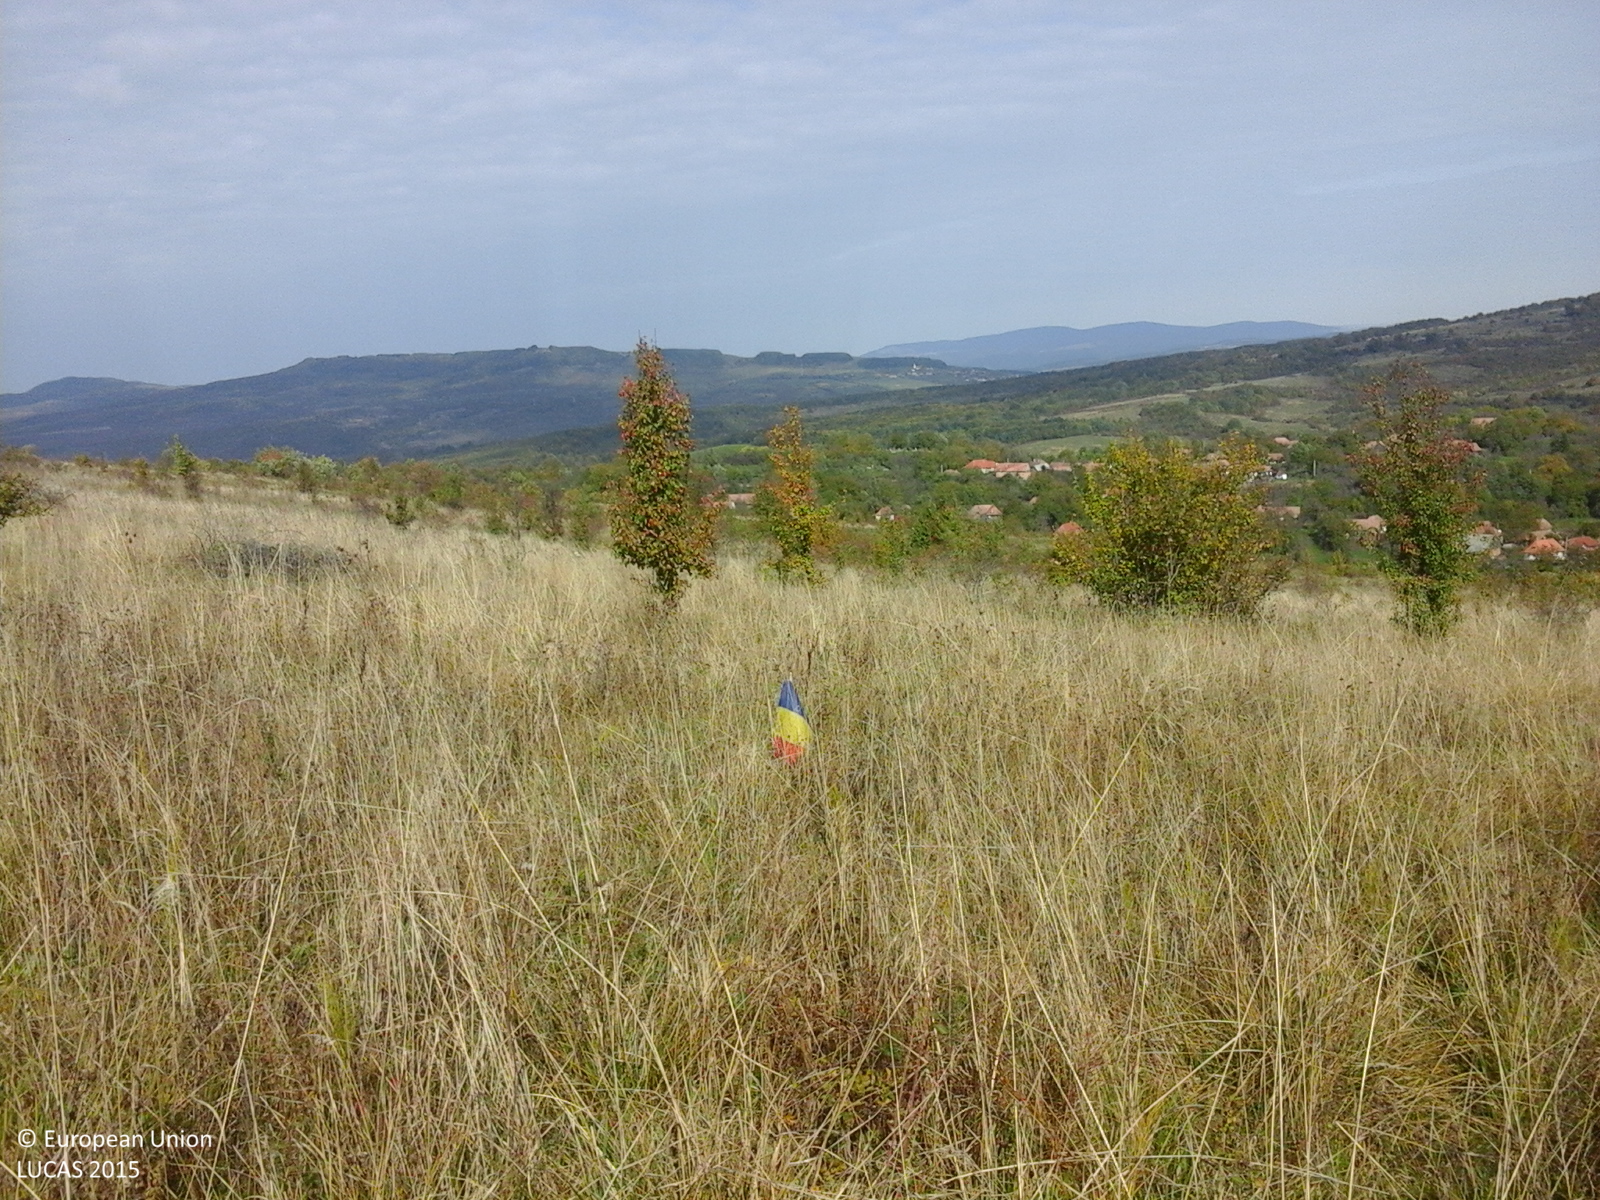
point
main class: Grassland
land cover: Grassland with sparse tree/shrub cover
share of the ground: > 75 %
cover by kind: herbaceous plants 85 %, shrubs 10 %, broadleaved forest trees 5 %
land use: Agriculture (excluding fallow land and kitchen gardens)
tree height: > 5 m
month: October
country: RO
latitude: 46.4247
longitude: 25.1023
